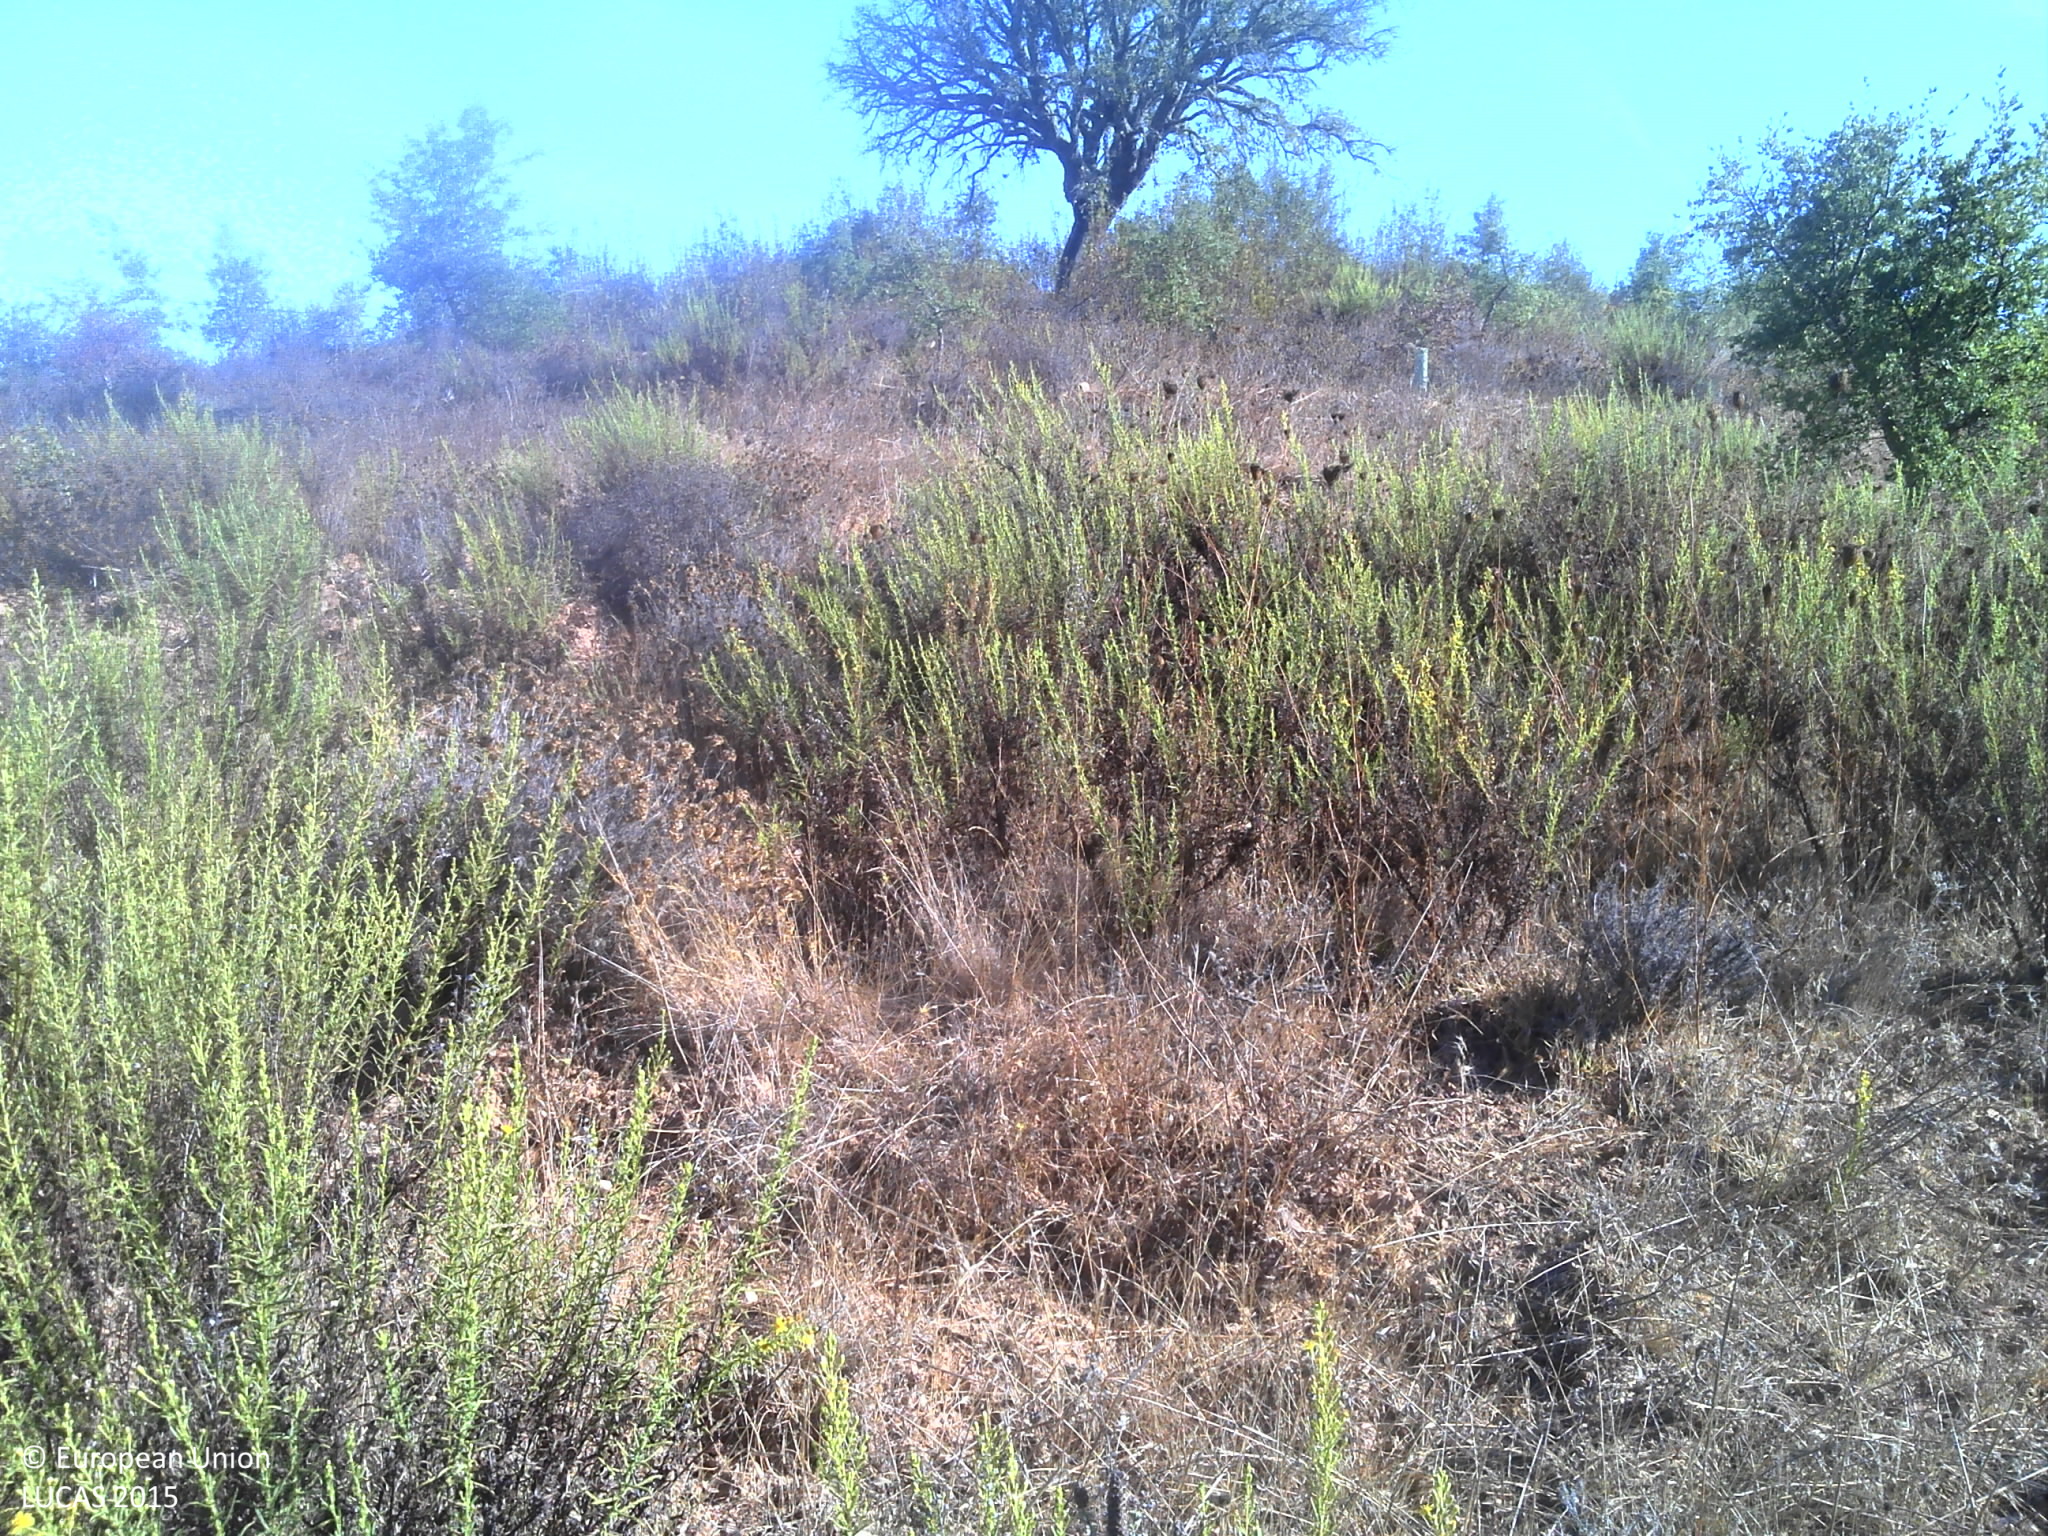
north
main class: Woodland
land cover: Broadleaved woodland
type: broadleaved evergreen forest
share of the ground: 10 - 25 %
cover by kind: shrubs 40 %, unconsolidated bare surface 35 %, broadleaved forest trees 25 %
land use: Forestry
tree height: < 5 m
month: August
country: PT
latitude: 37.5912
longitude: -8.4597
